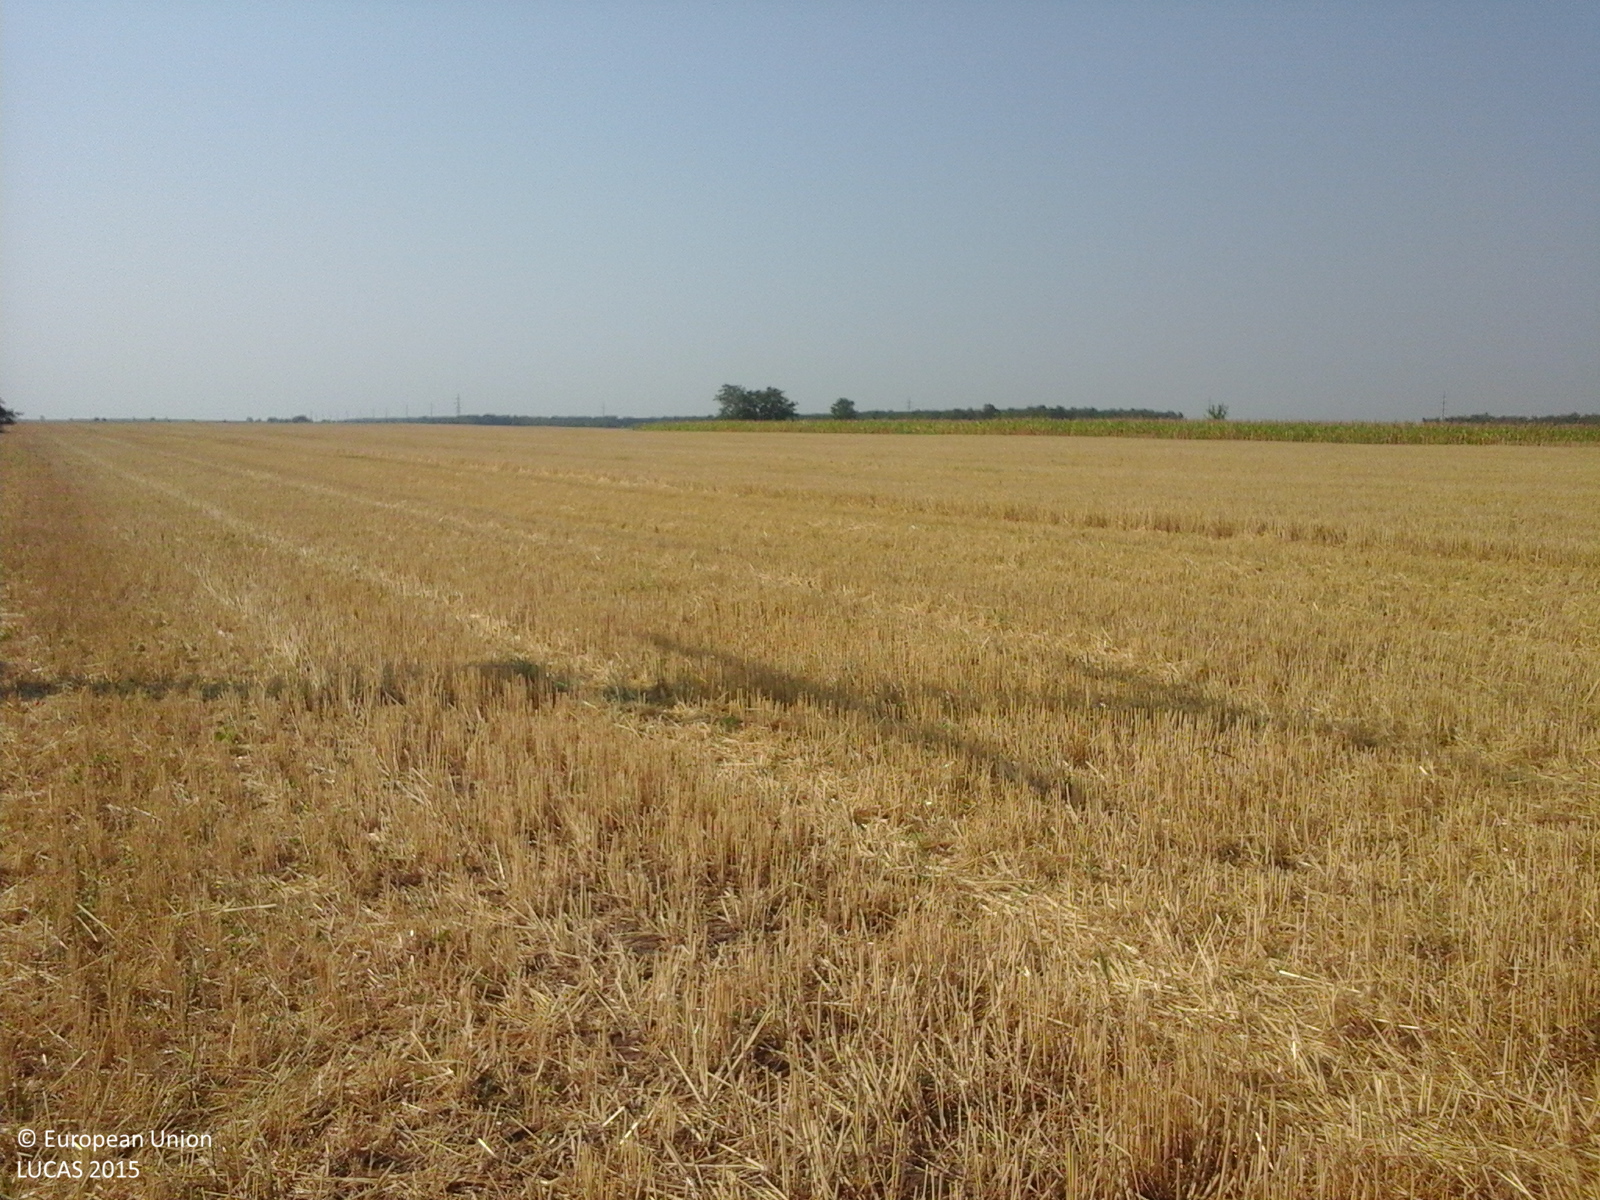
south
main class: Cropland
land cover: Common wheat
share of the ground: > 75 %
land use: Agriculture (excluding fallow land and kitchen gardens)
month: August
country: RO
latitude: 45.7336
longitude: 27.5444
